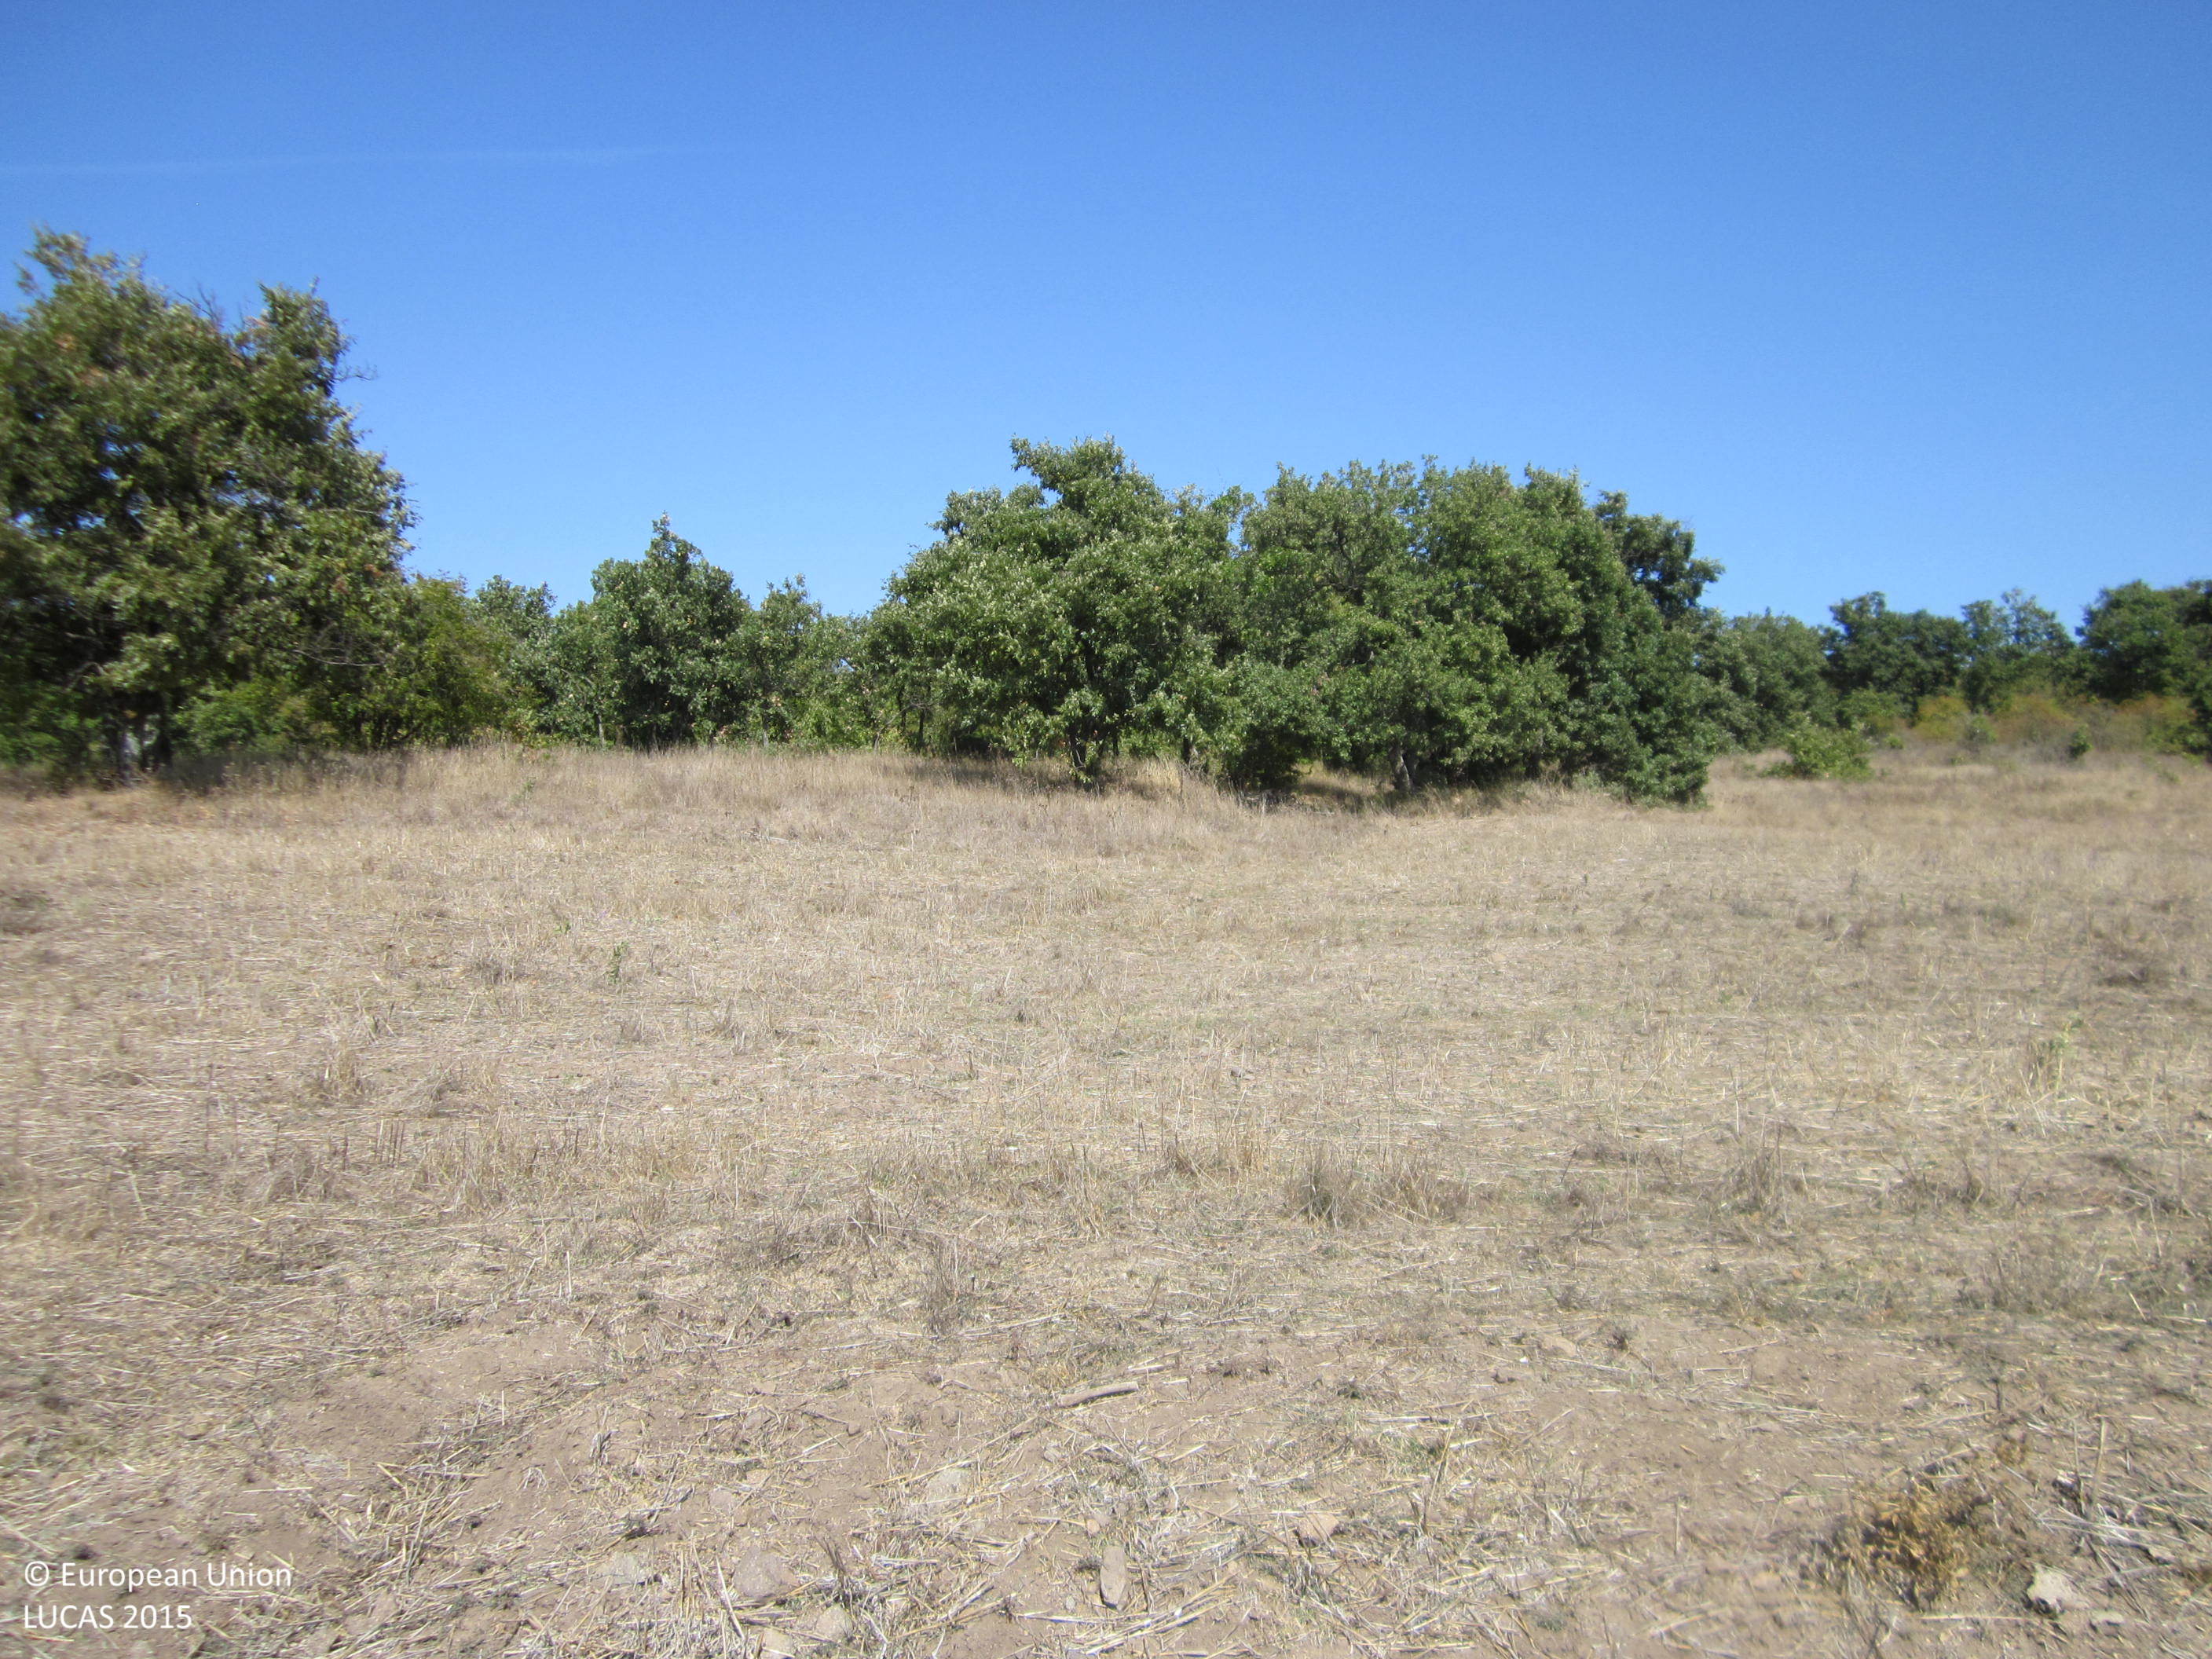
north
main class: Cropland
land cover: Common wheat
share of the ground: < 10 %
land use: Agriculture (excluding fallow land and kitchen gardens)
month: September
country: BG
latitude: 42.6980
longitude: 27.4157
